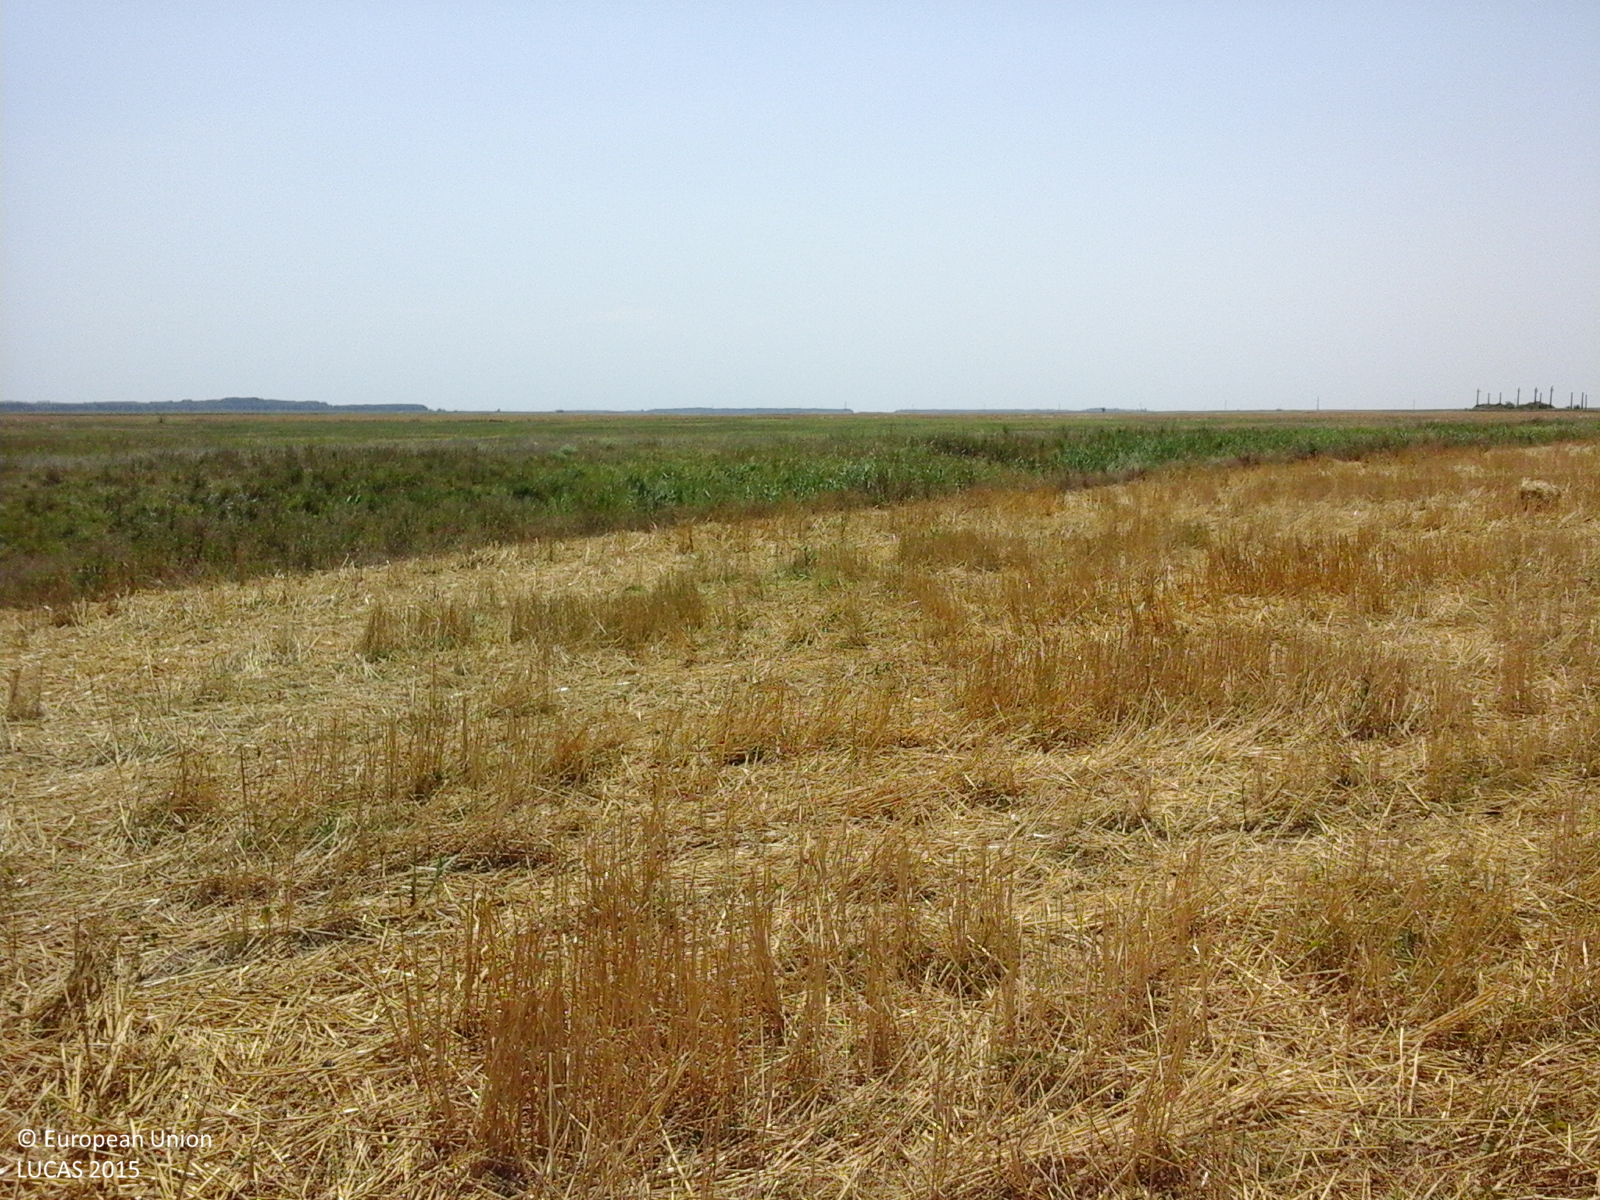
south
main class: Cropland
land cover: Common wheat
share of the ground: < 10 %
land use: Agriculture (excluding fallow land and kitchen gardens)
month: August
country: RO
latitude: 45.5337
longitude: 27.6372
